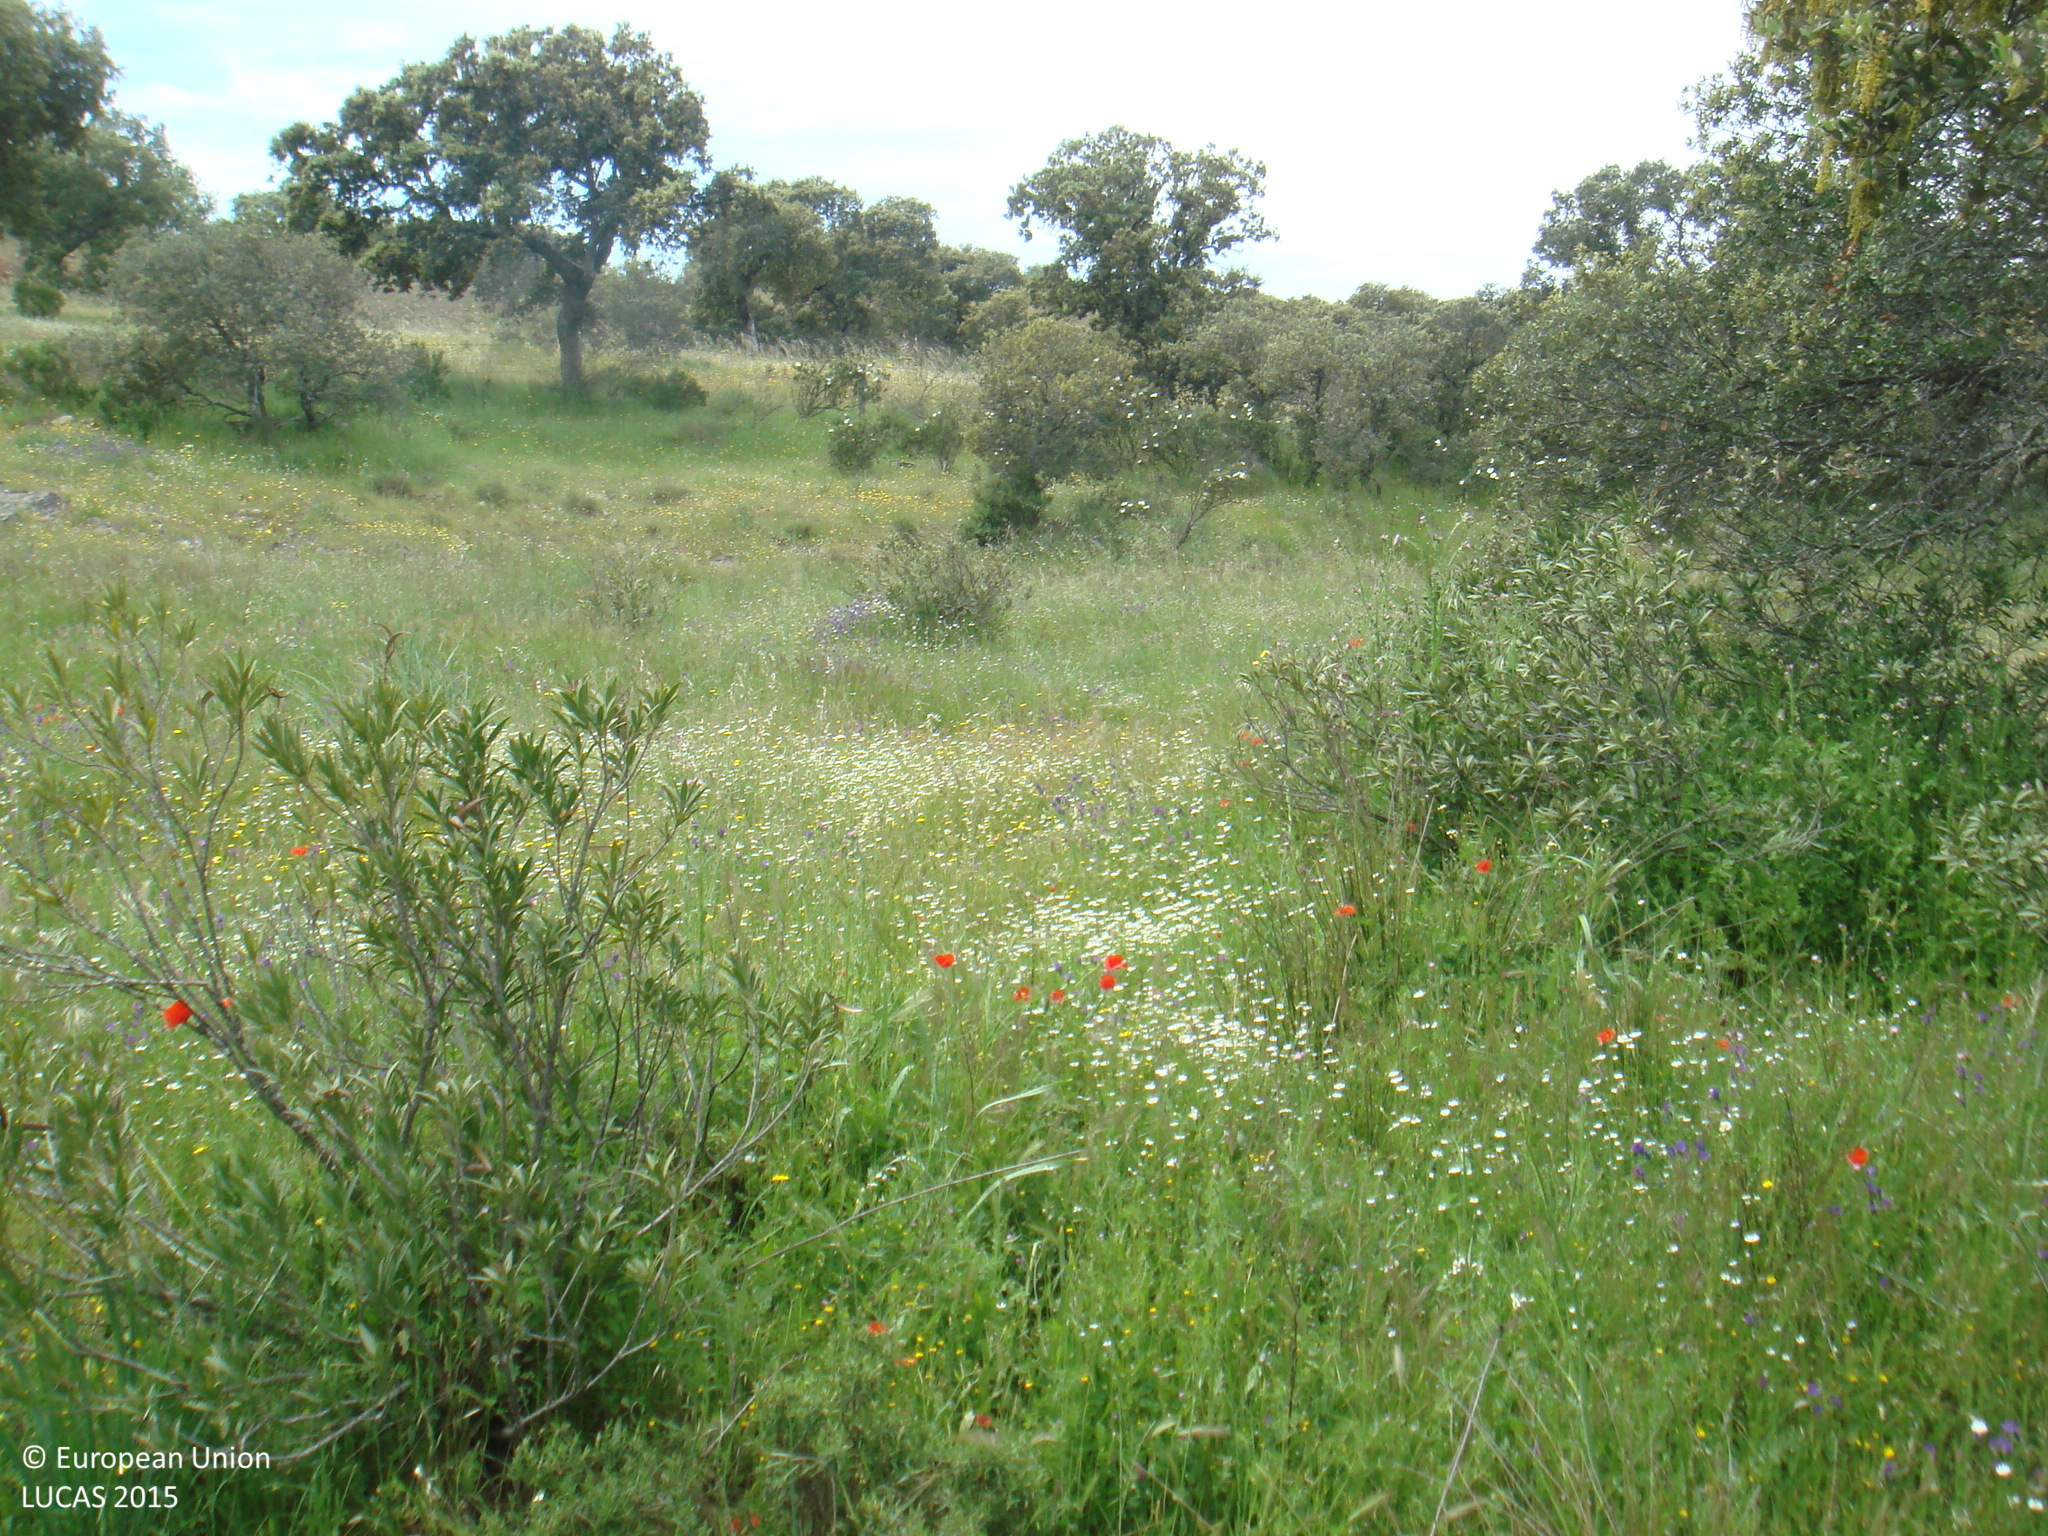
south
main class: Woodland
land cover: Broadleaved woodland
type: broadleaved evergreen forest
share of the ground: 10 - 25 %
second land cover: Grassland without tree/shrub cover
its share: > 75 %
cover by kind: herbaceous plants 80 %, broadleaved forest trees 15 %, shrubs 5 %
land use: Forestry
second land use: Agriculture (excluding fallow land and kitchen gardens)
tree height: > 5 m
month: May
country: ES
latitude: 38.3420
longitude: -5.0715
